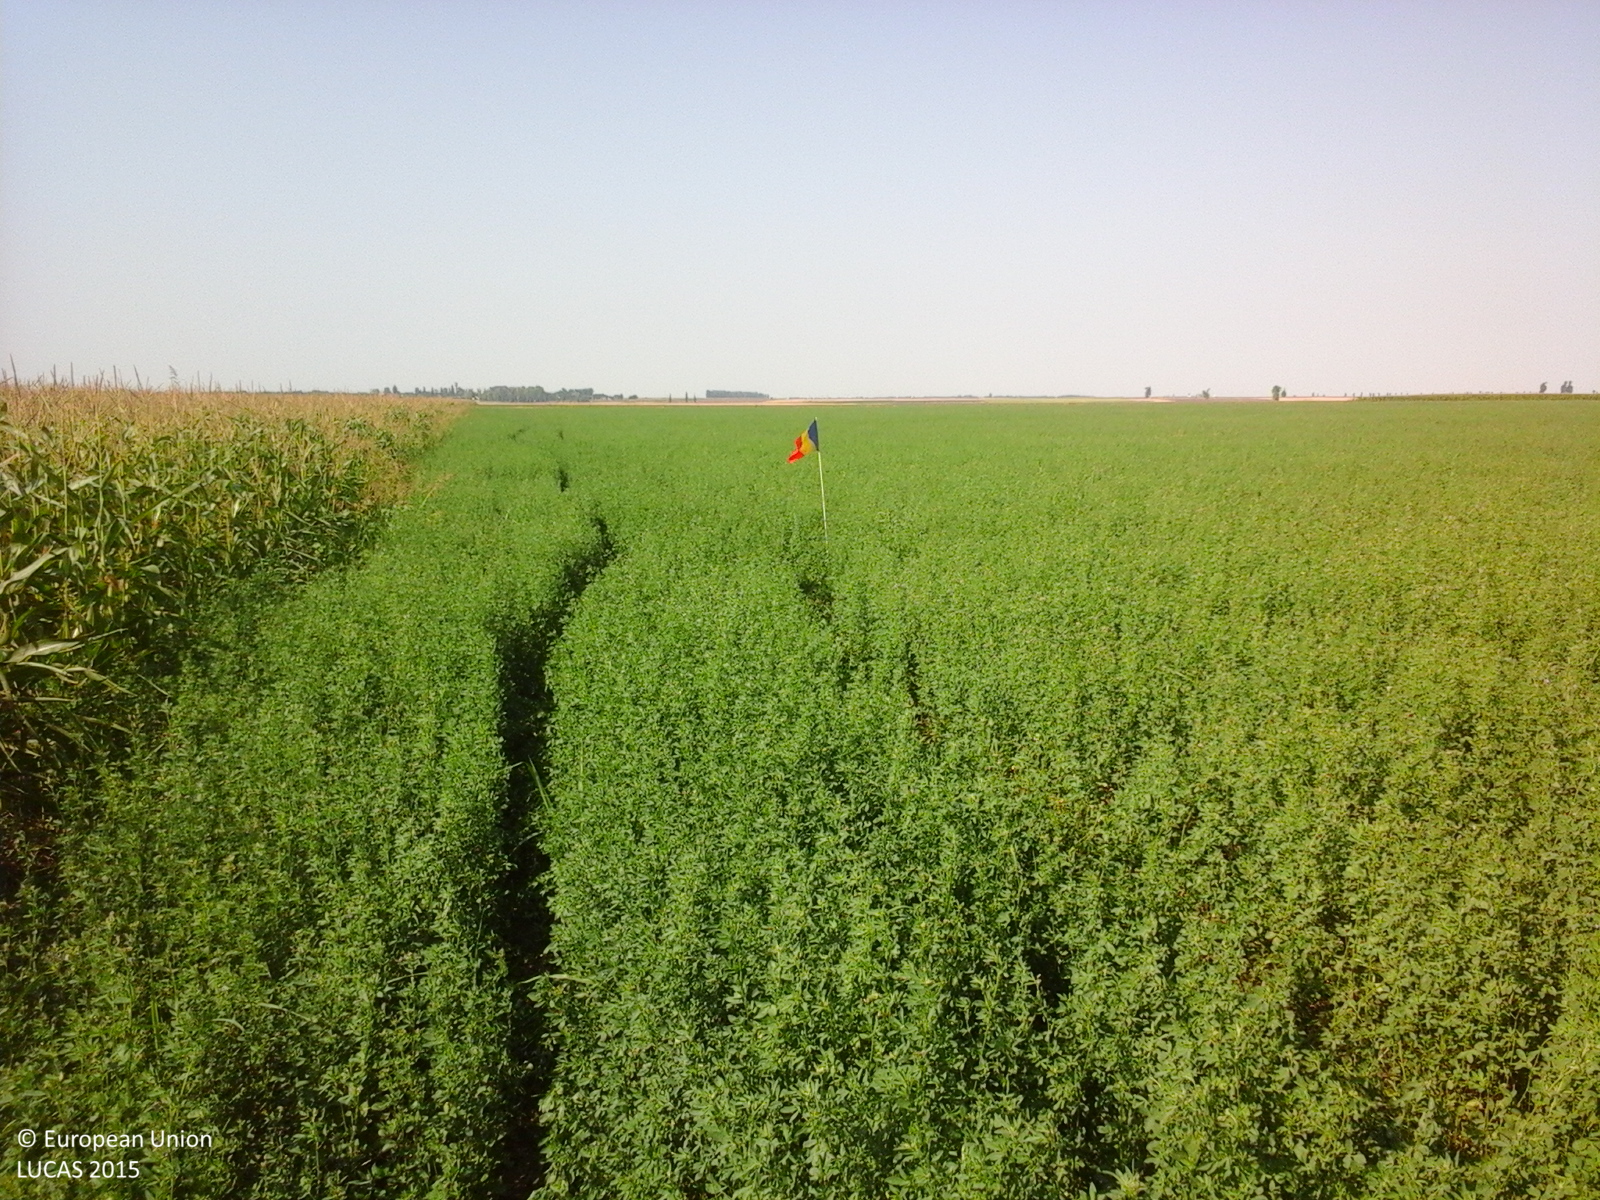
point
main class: Cropland
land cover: Lucerne
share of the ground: > 75 %
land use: Agriculture (excluding fallow land and kitchen gardens)
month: July
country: RO
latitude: 44.7080
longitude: 27.2925
